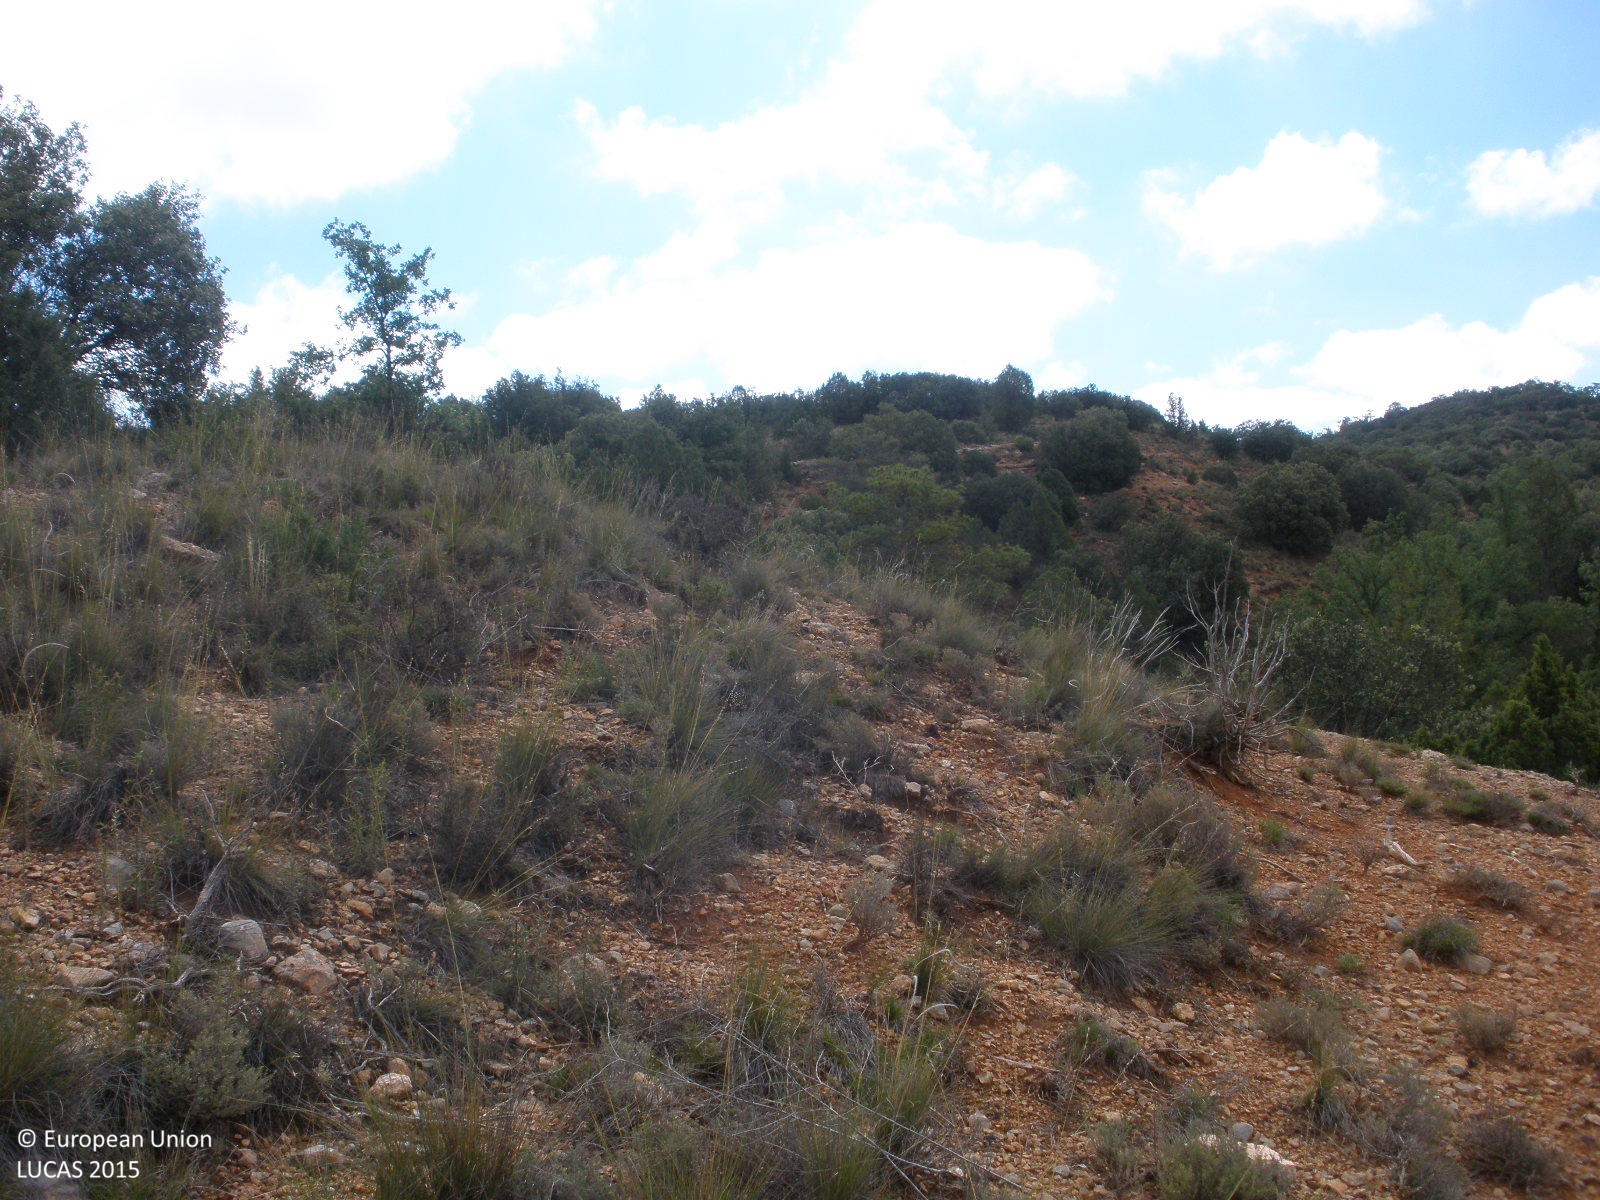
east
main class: Woodland
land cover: Other mixed woodland
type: coniferous forest of the mediterranean region
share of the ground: 25 - 50 %
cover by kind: shrubs 30 %, coniferous forest trees 20 %, broadleaved forest trees 20 %, consolidated bare surface 20 %, herbaceous plants 10 %
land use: Semi-natural and natural areas not in use
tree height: < 5 m
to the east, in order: Other mixed woodland
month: June
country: ES
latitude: 40.4660
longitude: -1.0149
